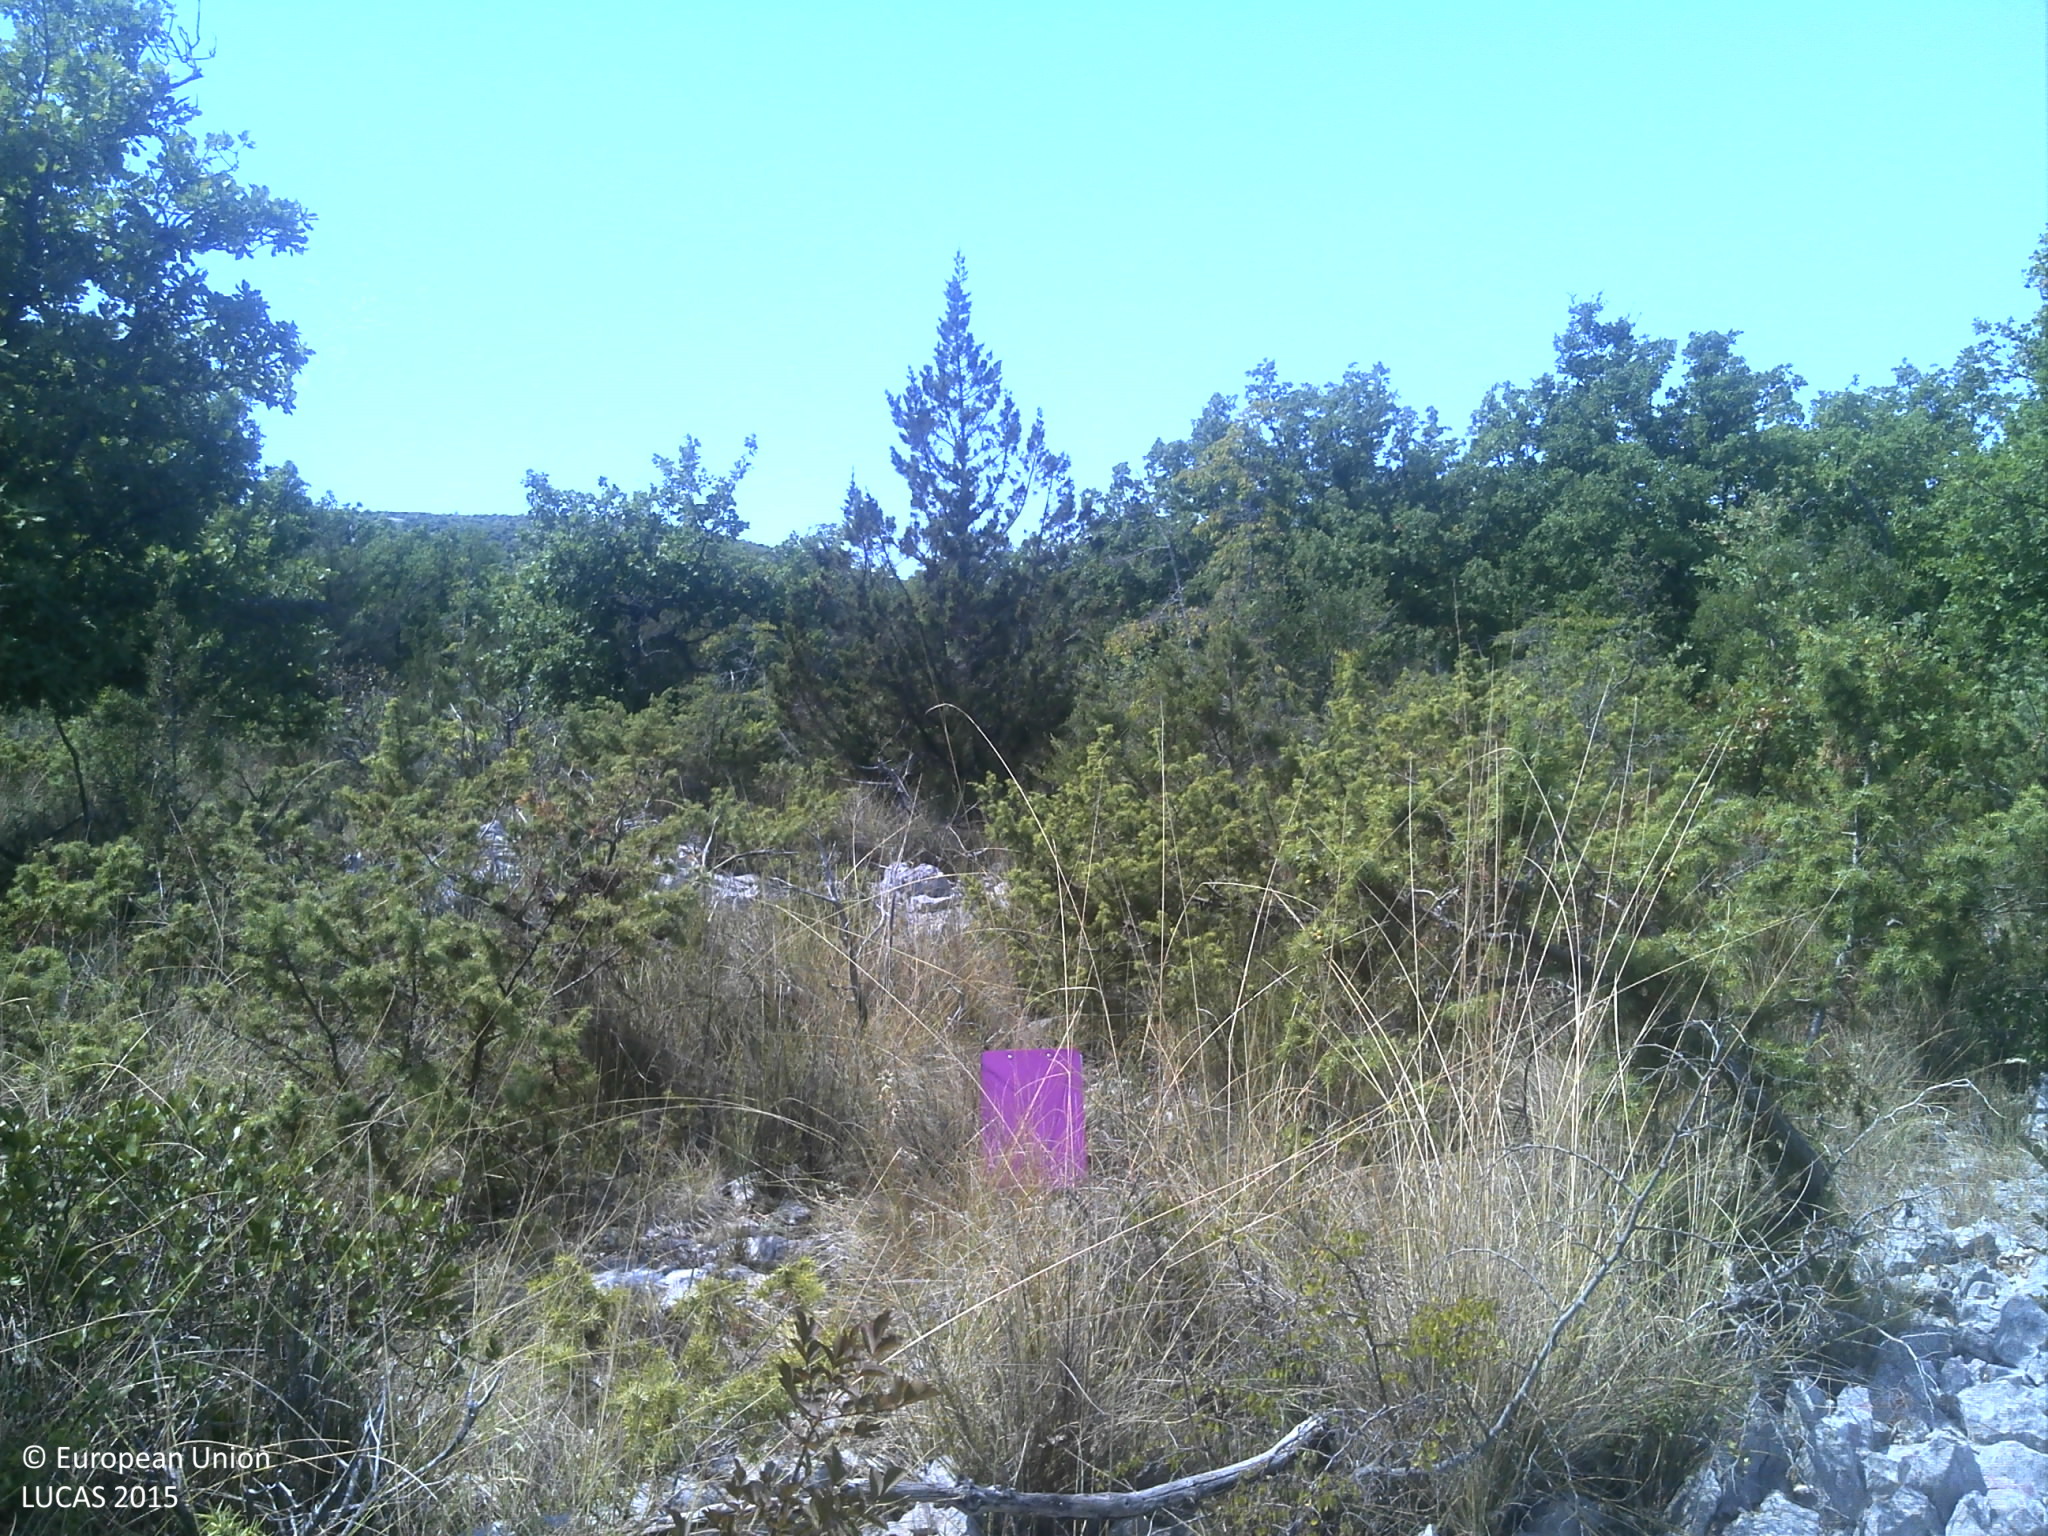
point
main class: Woodland
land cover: Broadleaved woodland
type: thermophilous deciduous forest
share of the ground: 25 - 50 %
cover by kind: shrubs 40 %, broadleaved forest trees 35 %, consolidated bare surface 10 %, unconsolidated bare surface 10 %, herbaceous plants 5 %
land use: Semi-natural and natural areas not in use
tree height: > 5 m
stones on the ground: > 50 %
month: August
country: HR
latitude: 43.8143
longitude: 15.6976
